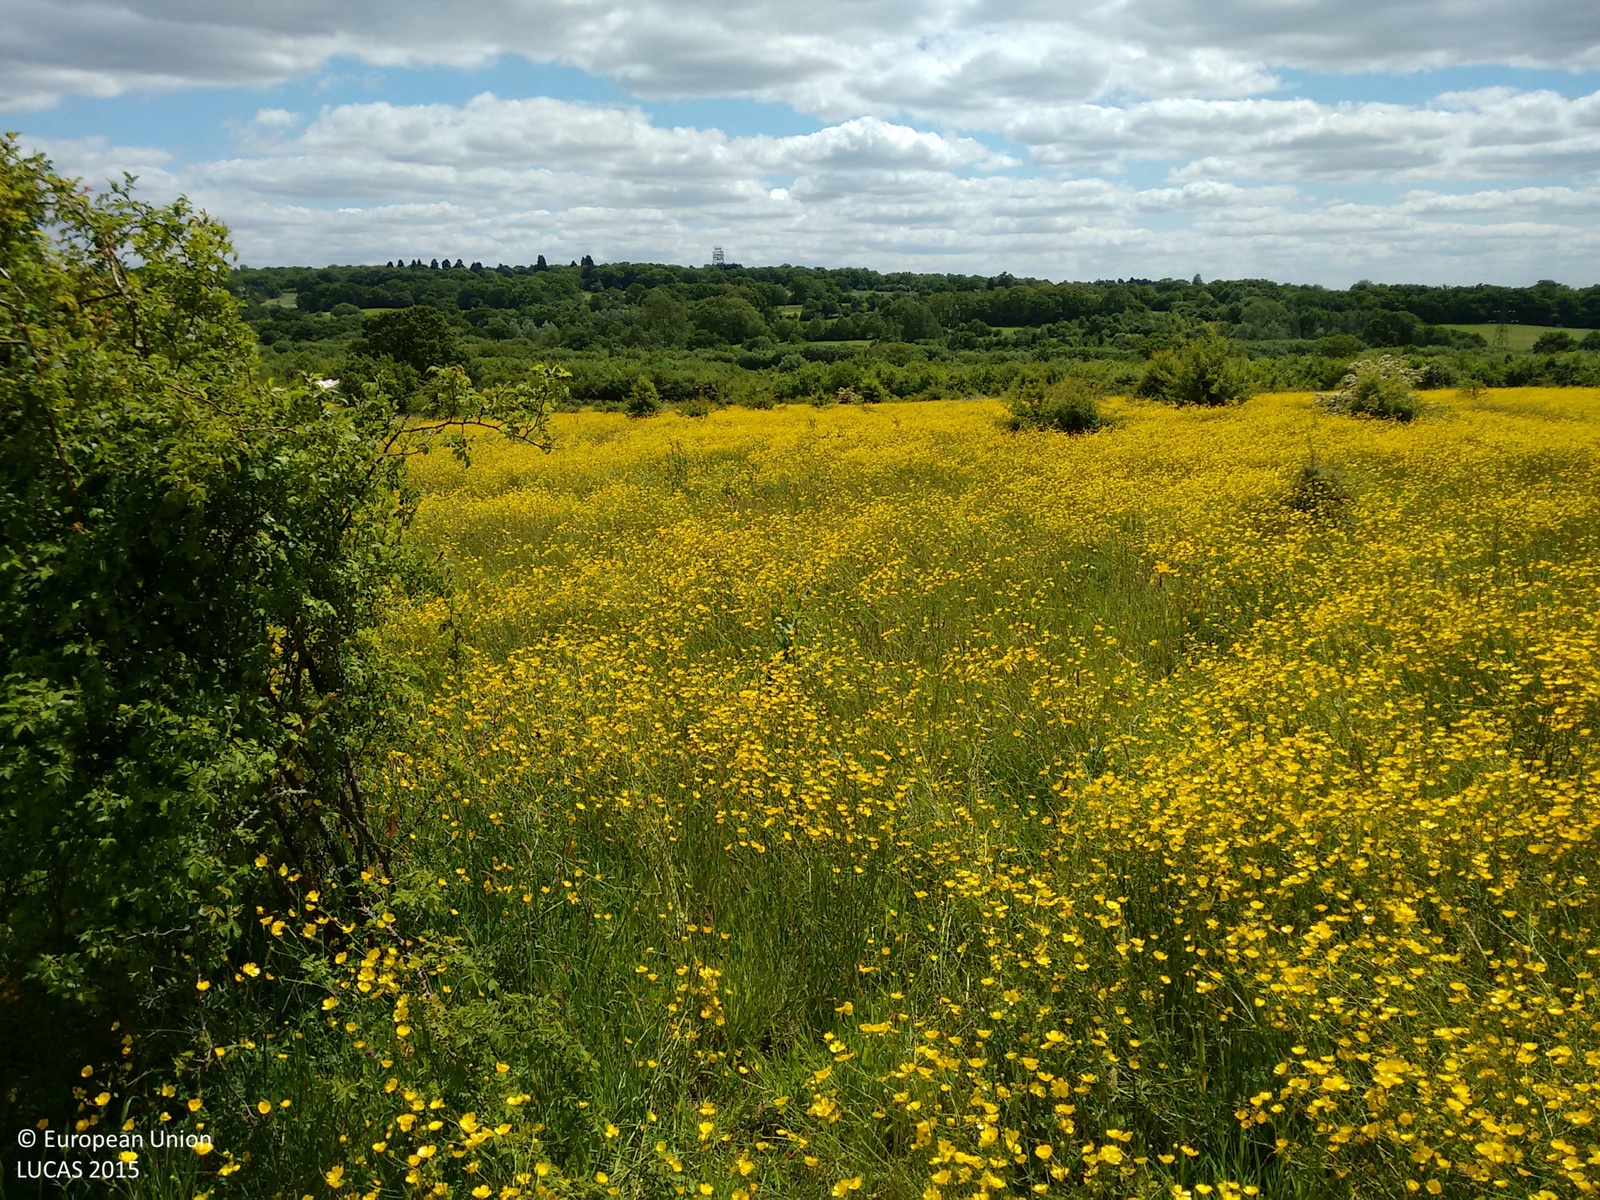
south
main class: Grassland
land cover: Grassland with sparse tree/shrub cover
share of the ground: > 75 %
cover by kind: herbaceous plants 95 %, broadleaved forest trees 5 %
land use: Agriculture (excluding fallow land and kitchen gardens)
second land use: Amenities, museums, leisure
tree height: < 5 m
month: June
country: GB
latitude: 51.6323
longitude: -0.3668
